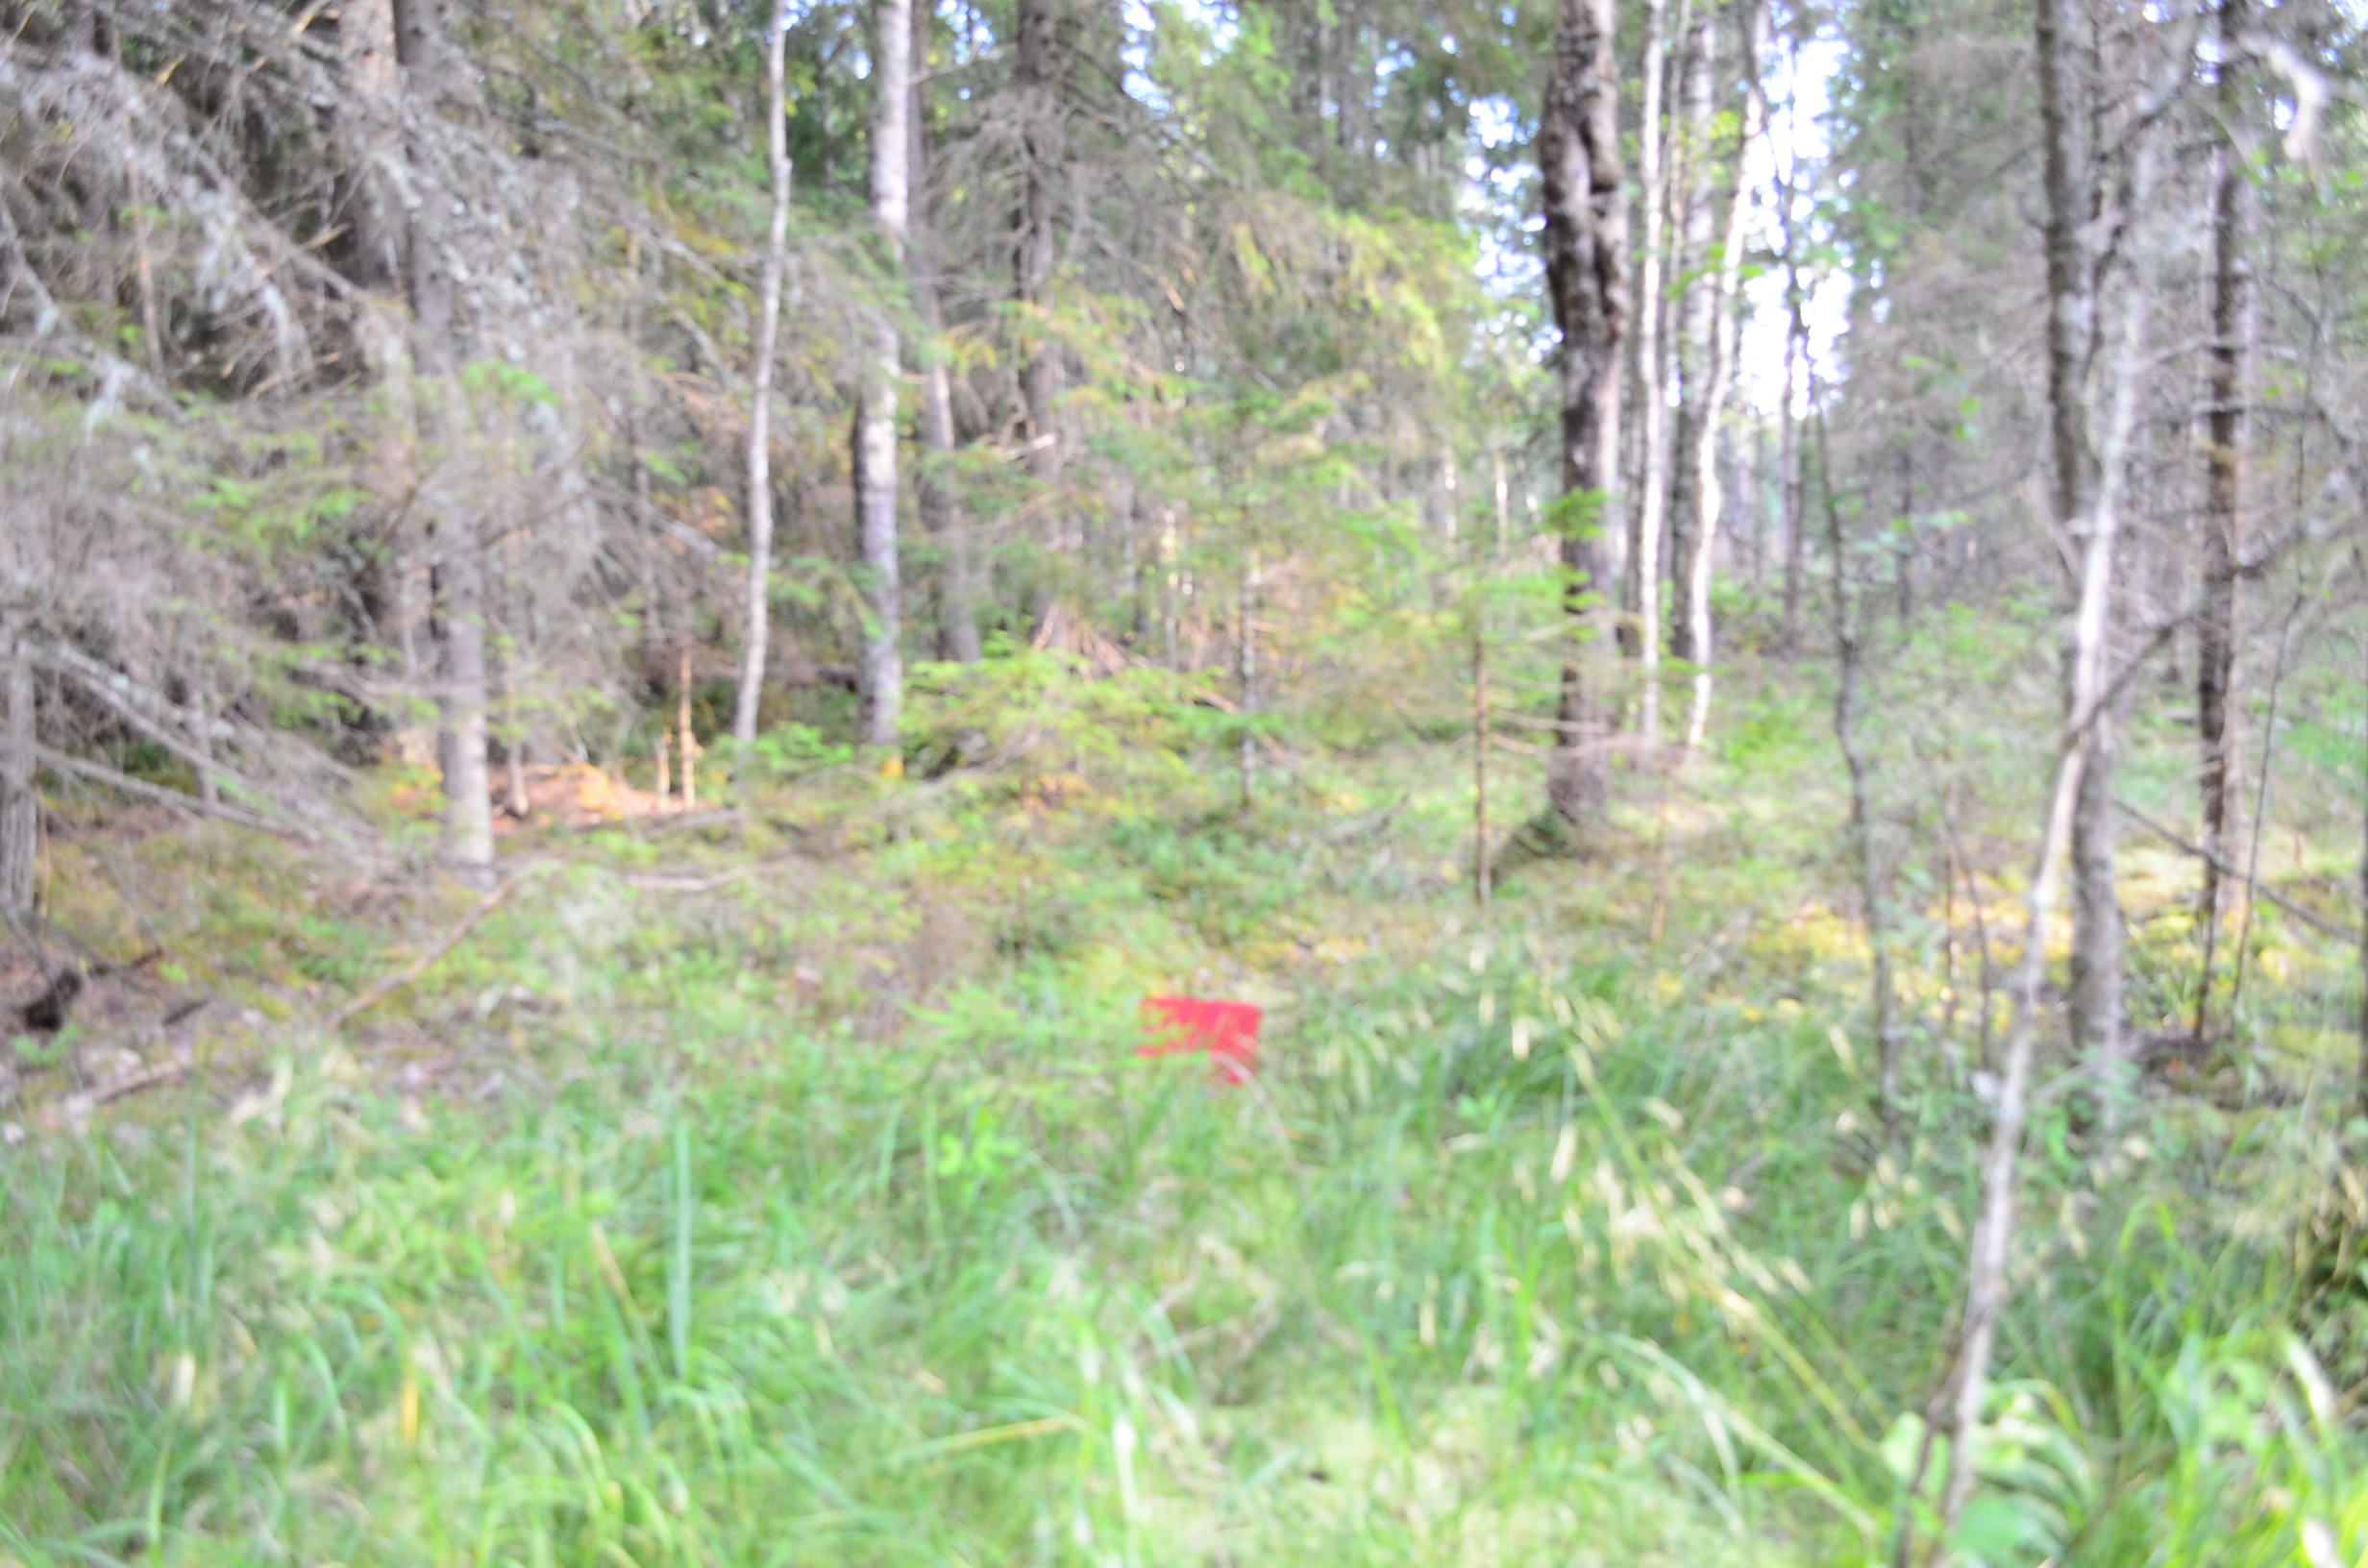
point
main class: Woodland
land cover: Other mixed woodland
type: hemiboreal forest and nemoral coniferous forest and mixed broadleaved-coniferous forest
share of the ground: > 75 %
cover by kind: broadleaved forest trees 45 %, coniferous forest trees 30 %, shrubs 15 %, herbaceous plants 10 %
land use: Forestry
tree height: > 5 m
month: July
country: LV
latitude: 57.0827
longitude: 22.3442
